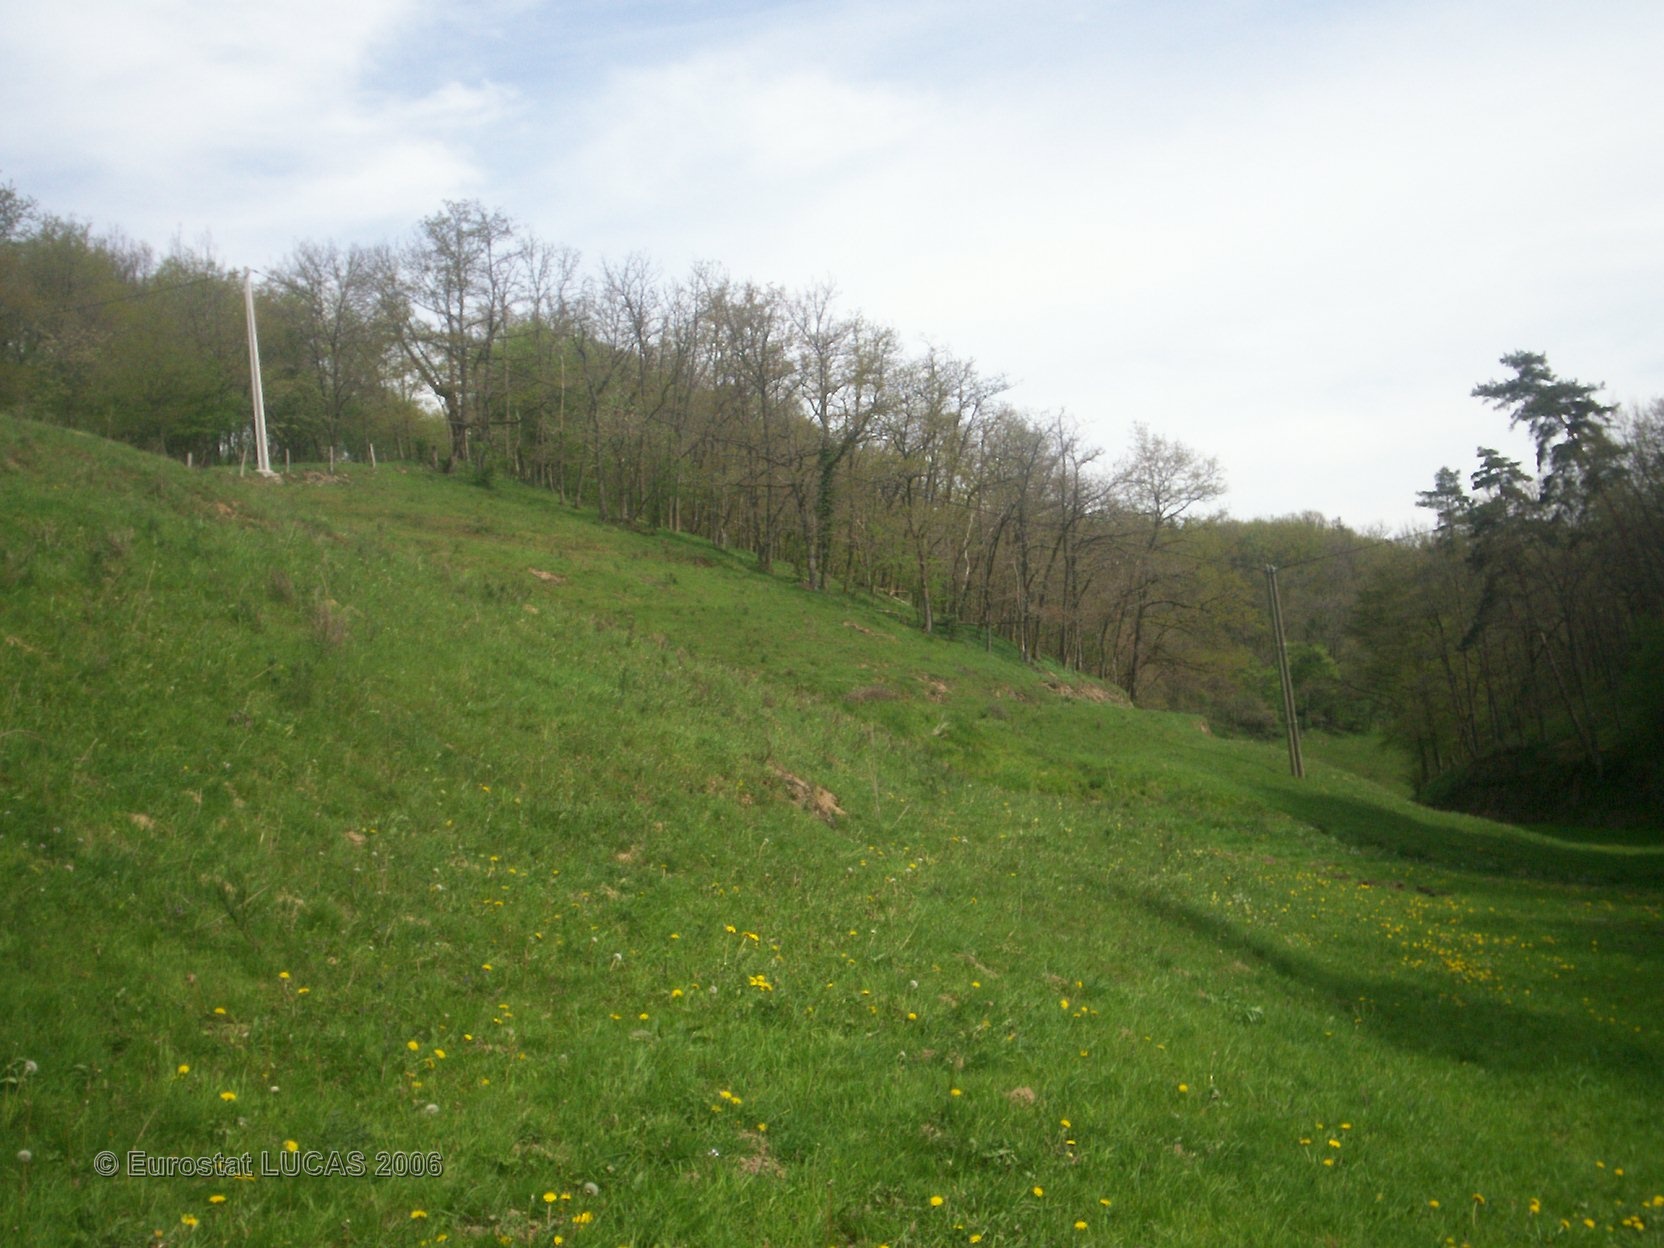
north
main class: Grassland
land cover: Grassland without tree/shrub cover
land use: Agriculture (excluding fallow land and kitchen gardens)
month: May
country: FR
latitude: 46.0072
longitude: 2.9085
